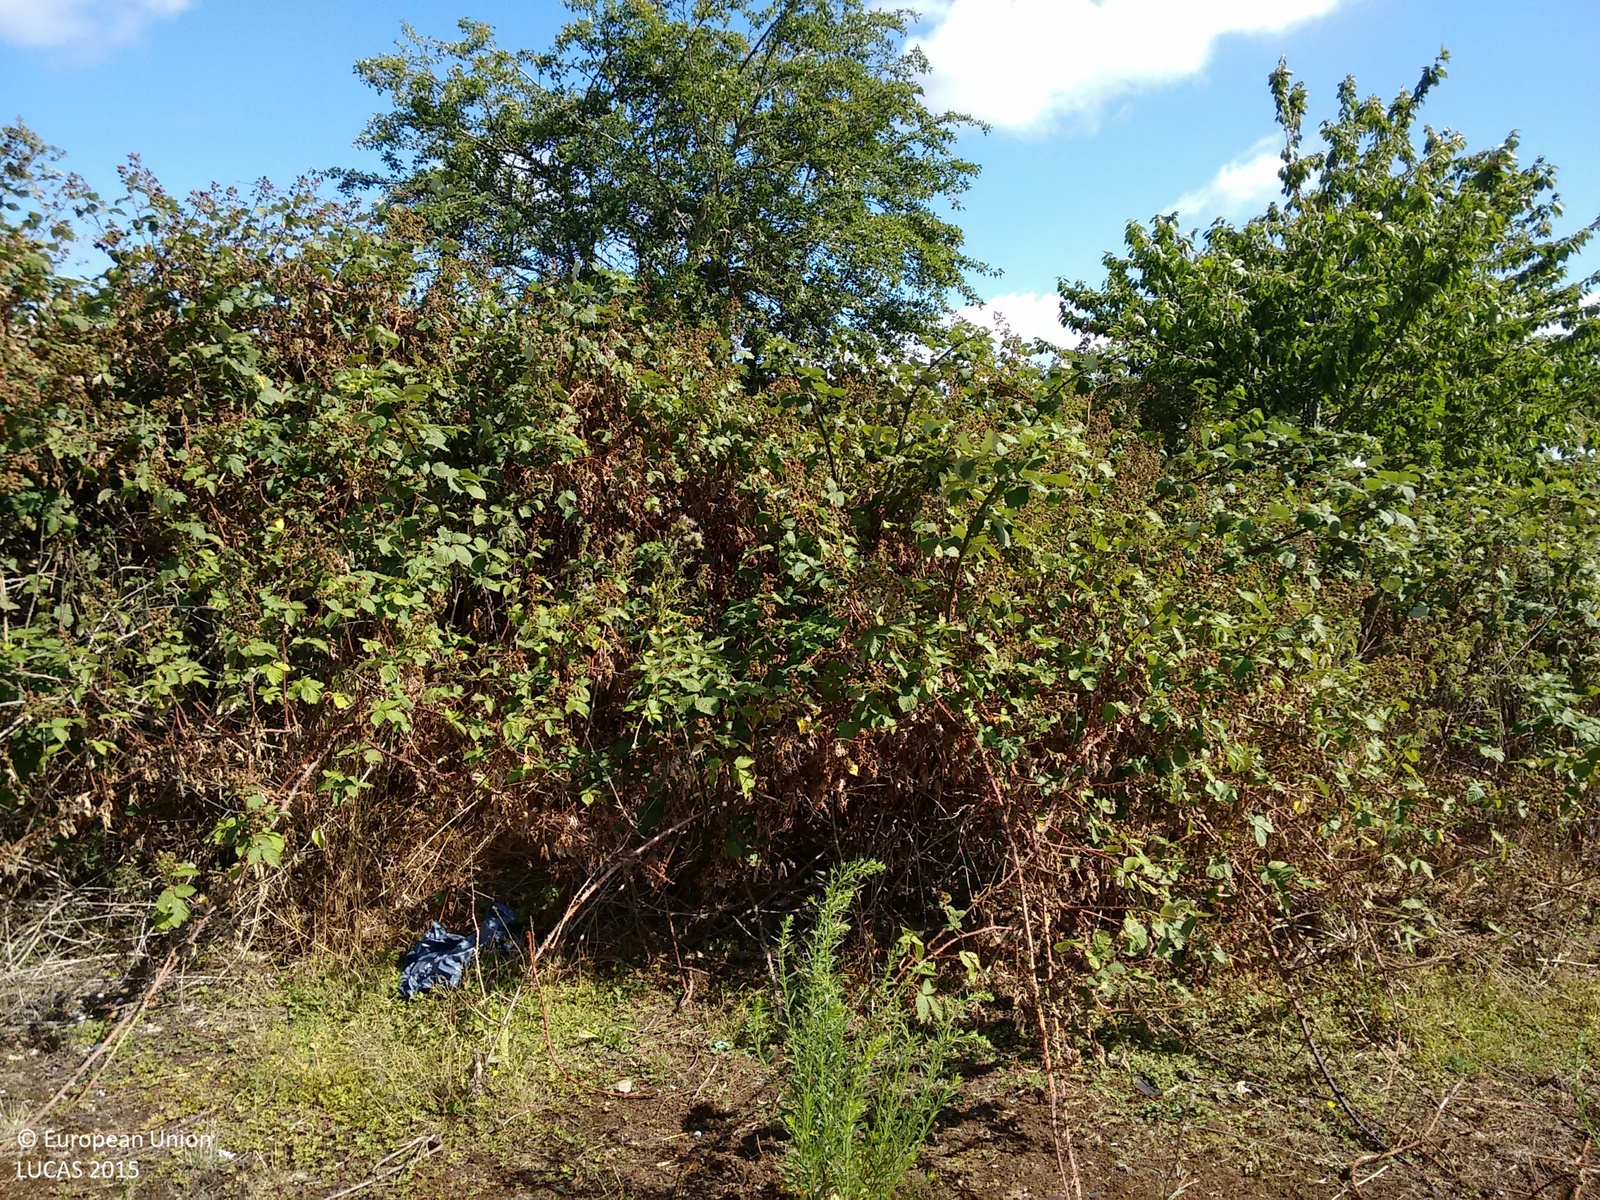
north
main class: Shrubland
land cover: Shrubland without tree cover
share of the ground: > 75 %
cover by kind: shrubs 50 %, herbaceous plants 40 %, consolidated bare surface 10 %
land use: Fallow land
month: July
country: GB
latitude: 51.3986
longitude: -0.5460
